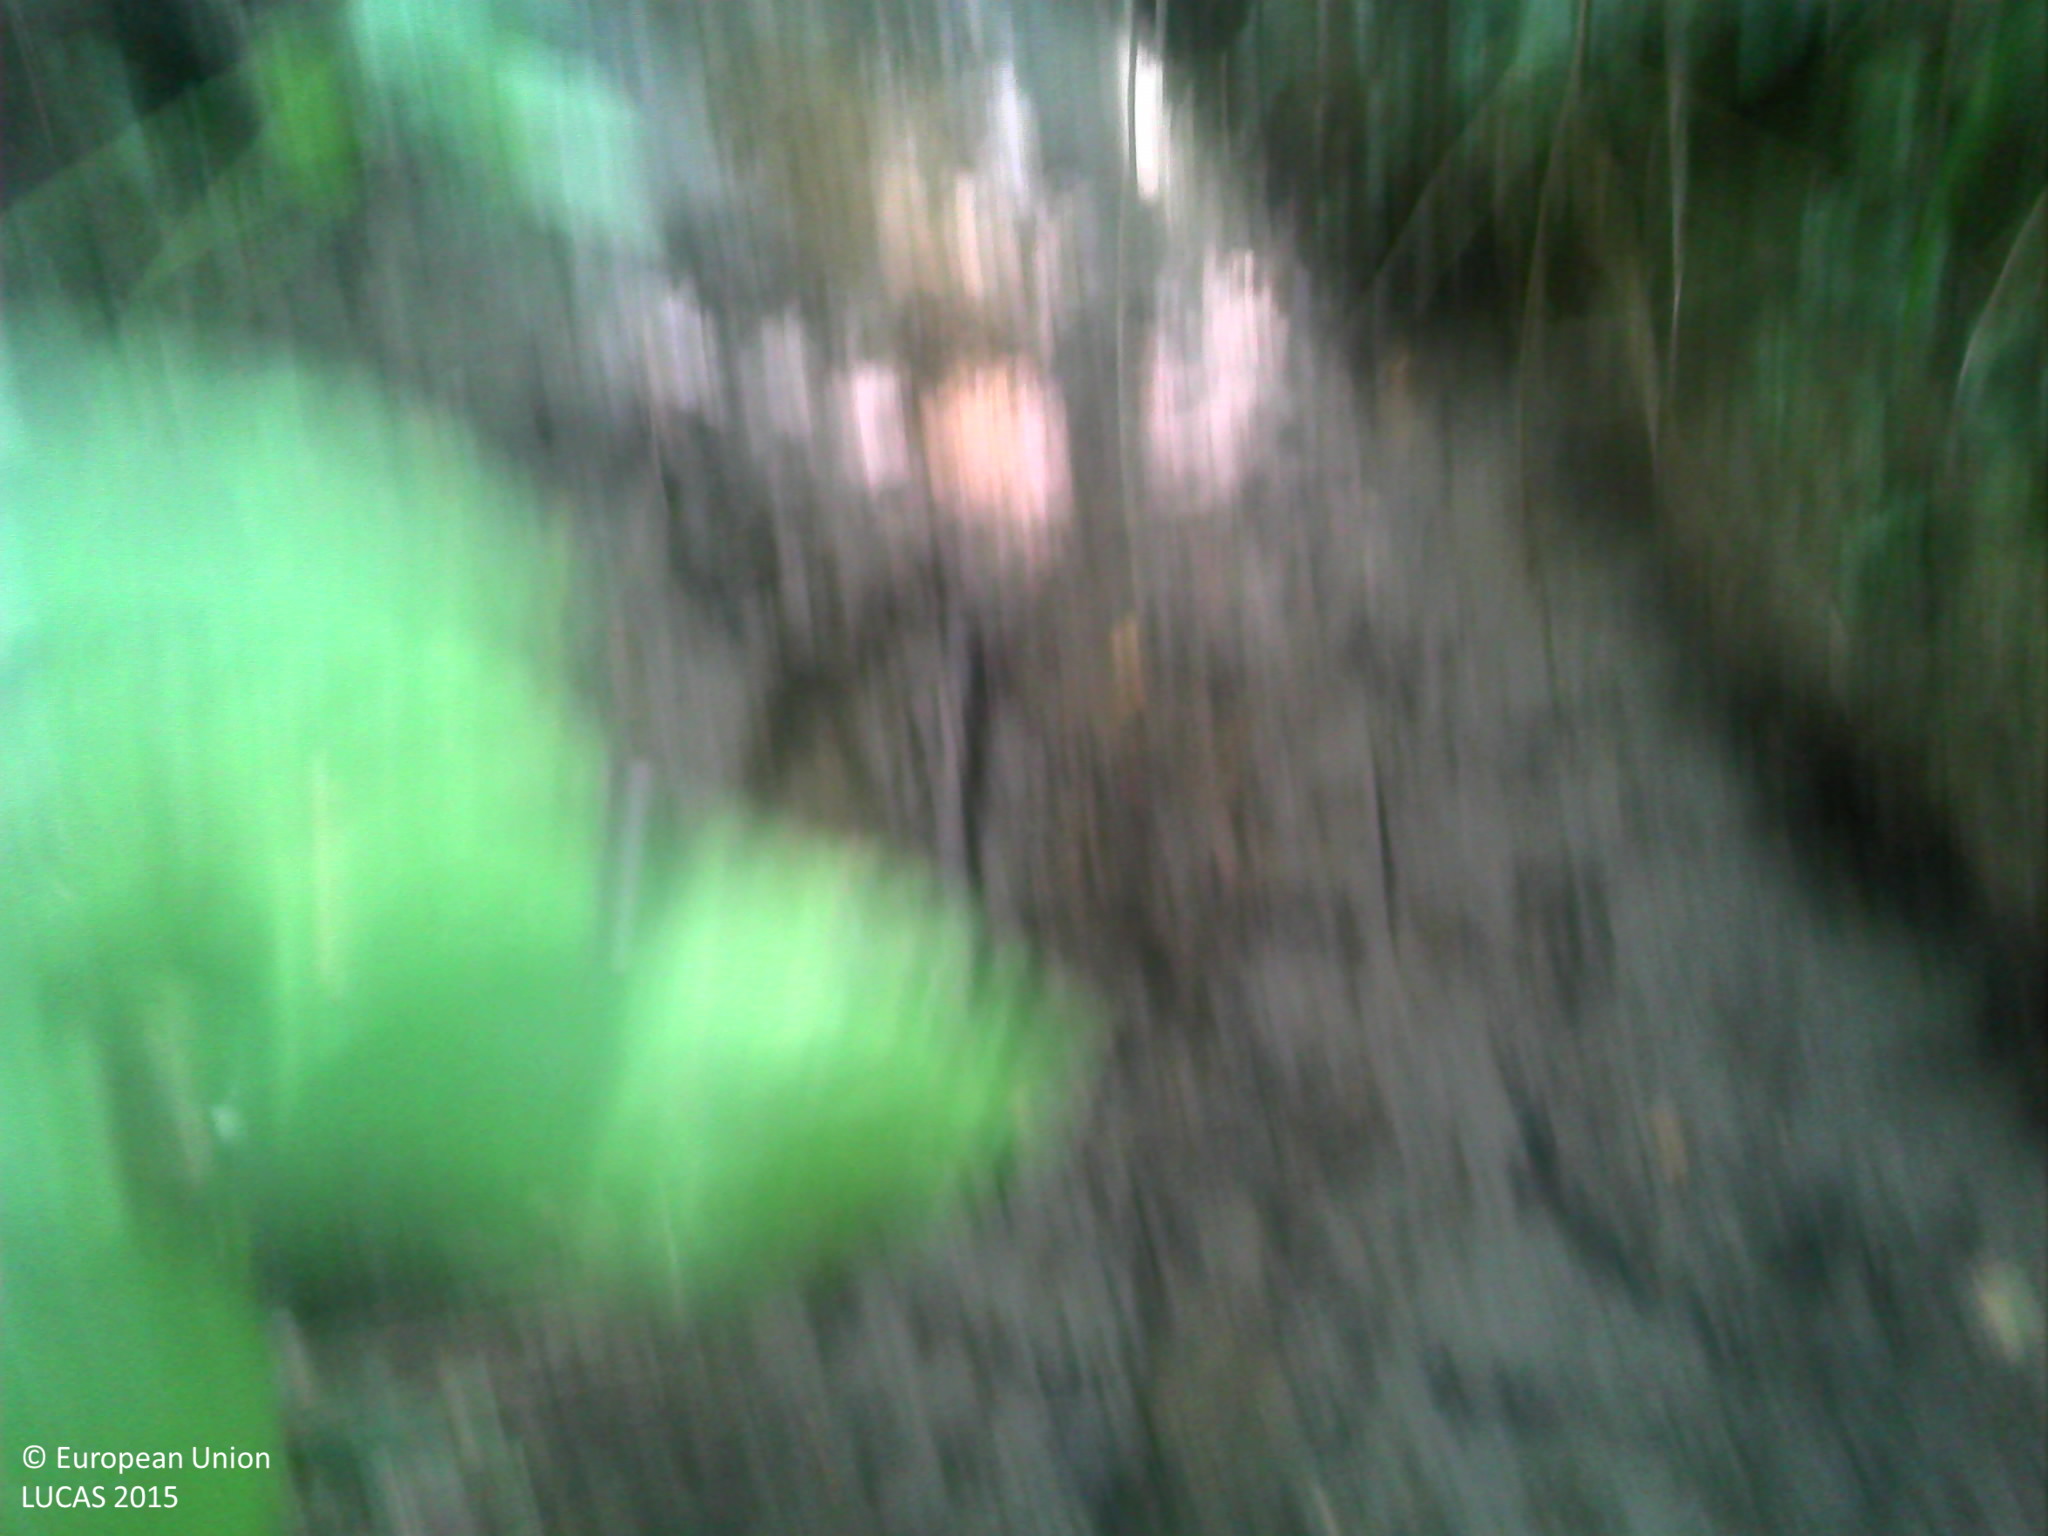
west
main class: Woodland
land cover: Broadleaved woodland
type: acidophilous oak and oak-birch forest
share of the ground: > 75 %
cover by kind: broadleaved forest trees 65 %, herbaceous plants 35 %
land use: Forestry
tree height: > 5 m
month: July
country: FR
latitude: 43.6099
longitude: 1.5904
